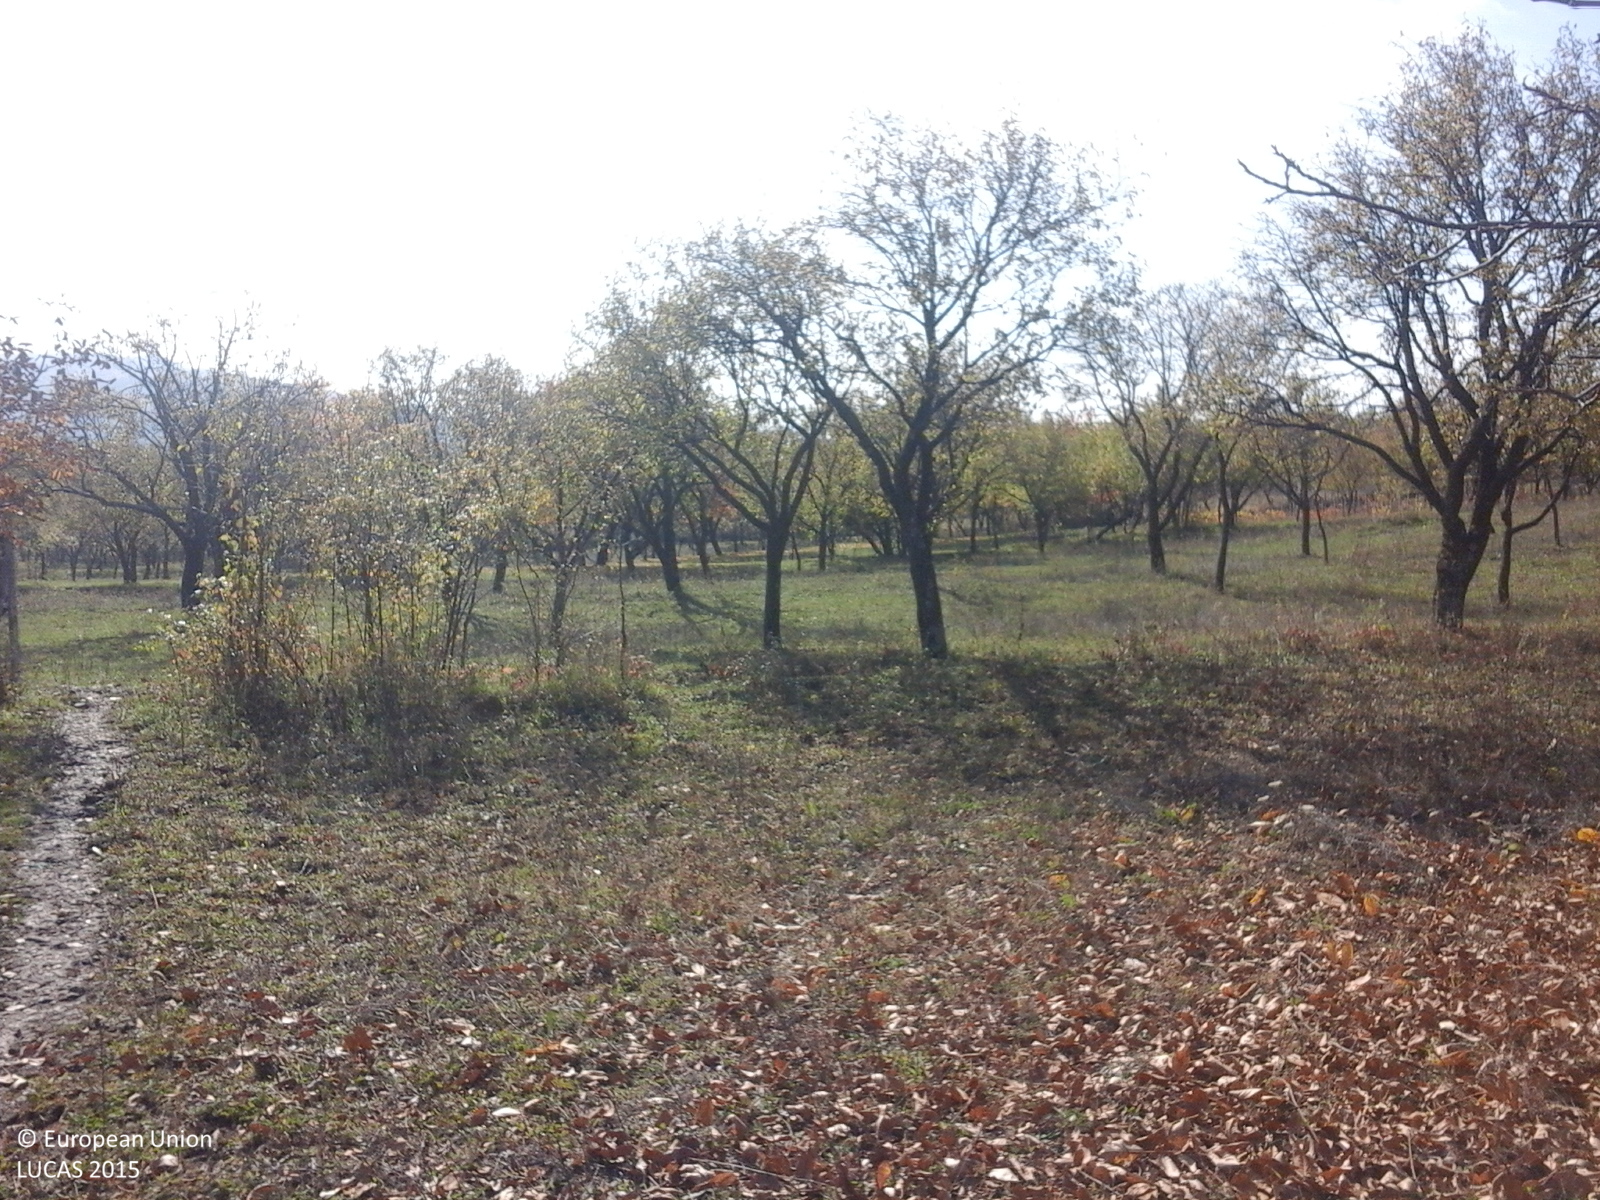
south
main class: Cropland
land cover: Nuts trees
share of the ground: > 75 %
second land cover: Grassland without tree/shrub cover
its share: > 75 %
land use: Agriculture (excluding fallow land and kitchen gardens)
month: October
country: RO
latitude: 45.6594
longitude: 26.9913
